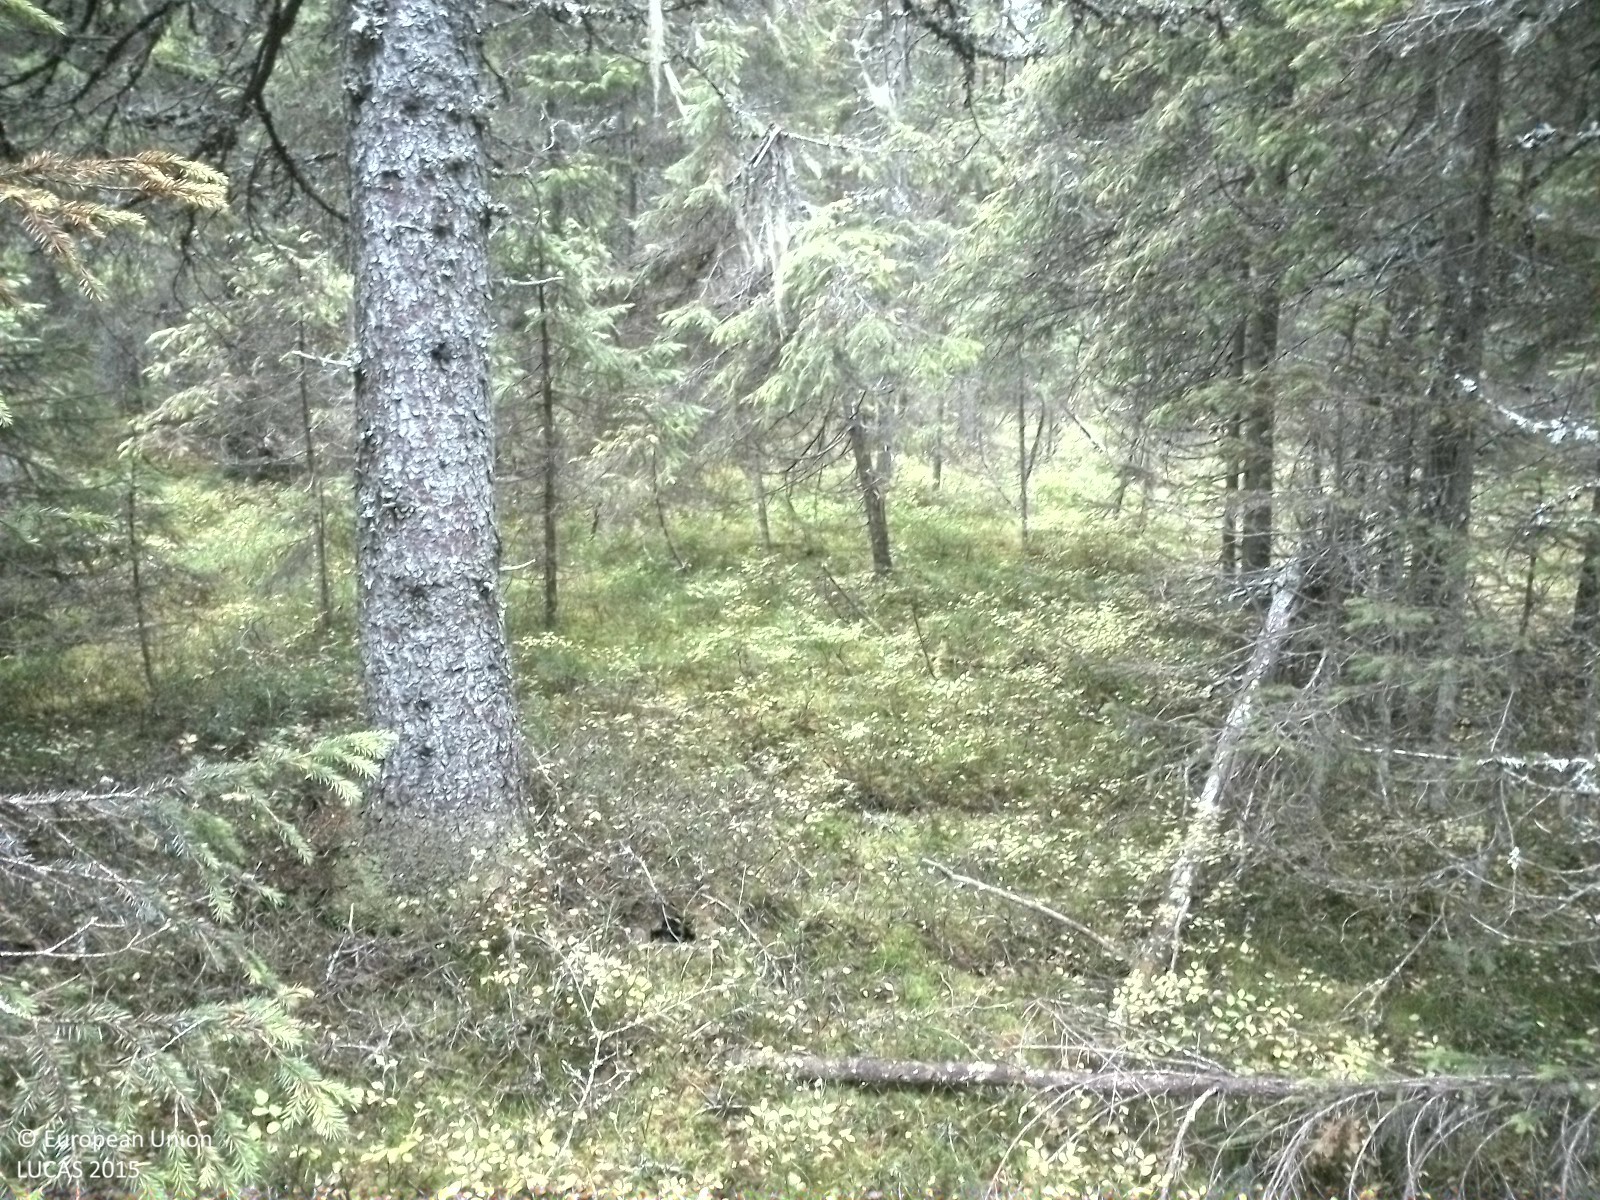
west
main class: Woodland
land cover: Spruce dominated coniferous woodland
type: boreal forest
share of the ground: > 75 %
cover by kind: coniferous forest trees 90 %, shrubs 10 %
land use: Forestry
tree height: > 5 m
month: October
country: SE
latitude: 63.5240
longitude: 14.9824
